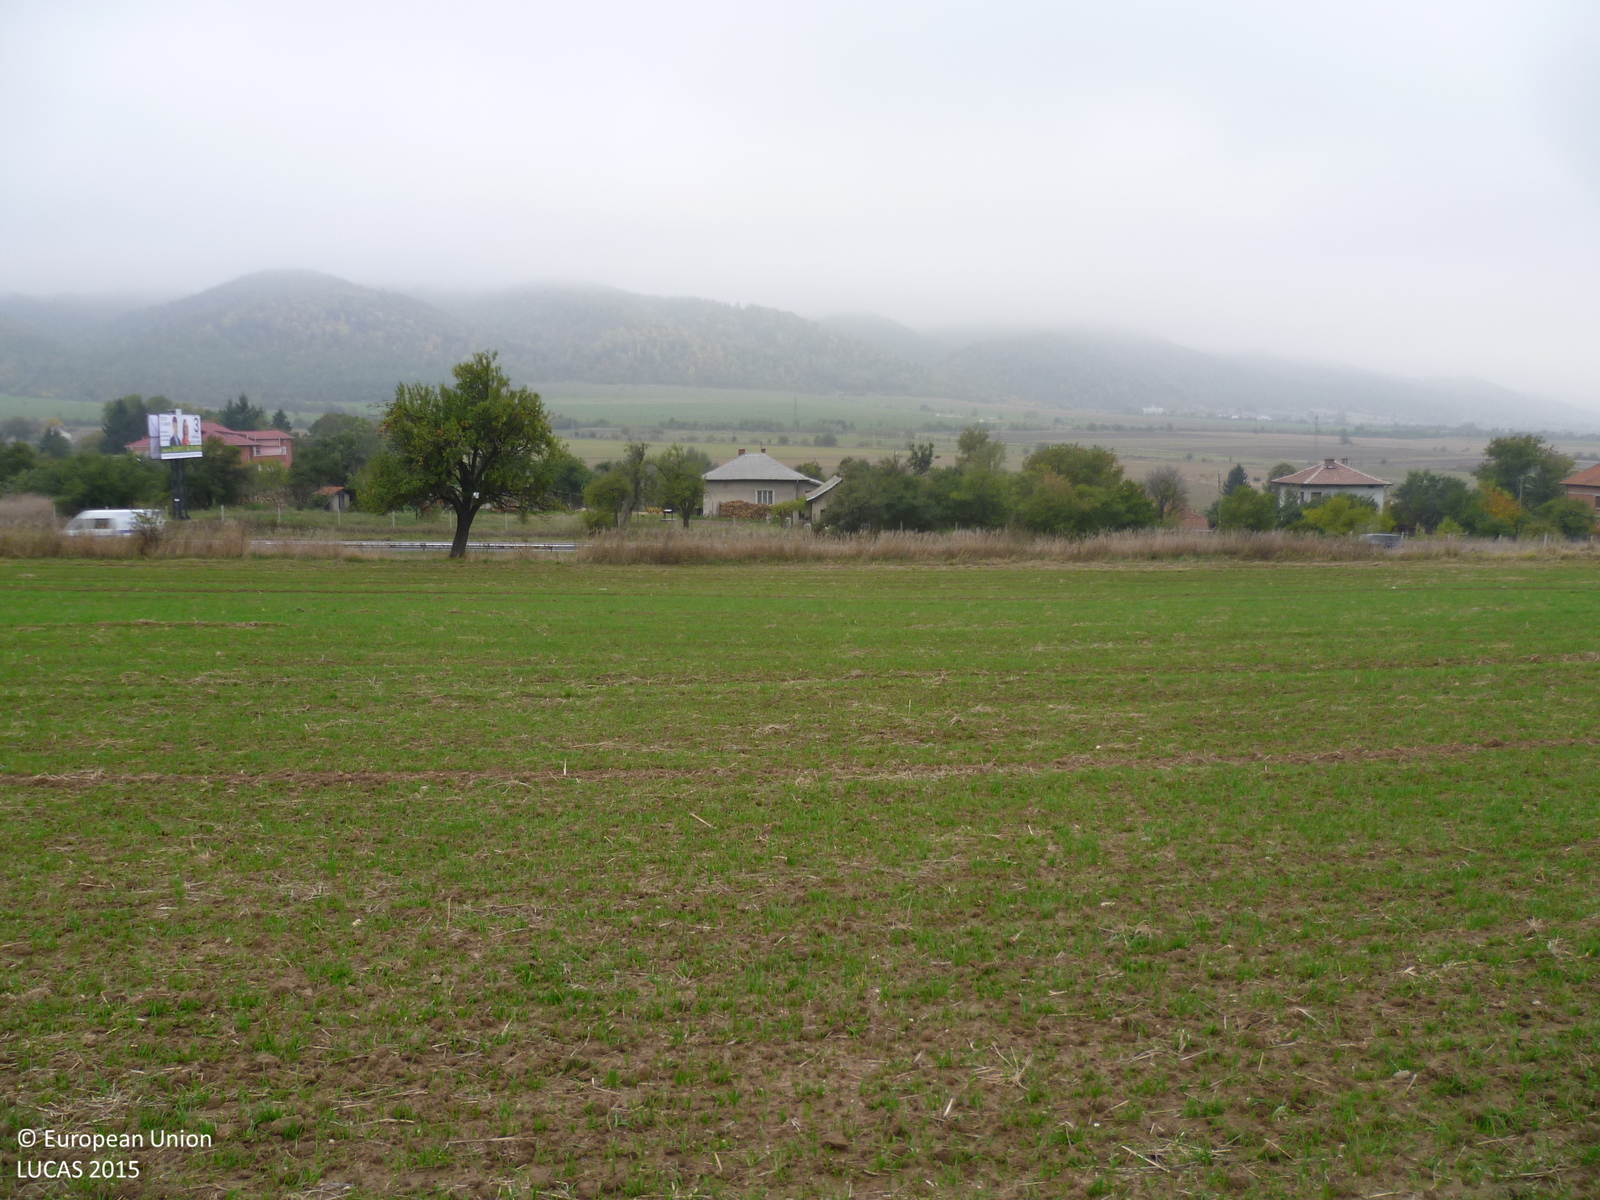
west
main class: Cropland
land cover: Durum wheat
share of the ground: 25 - 50 %
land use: Agriculture (excluding fallow land and kitchen gardens)
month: October
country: BG
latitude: 42.3891
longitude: 23.8750
